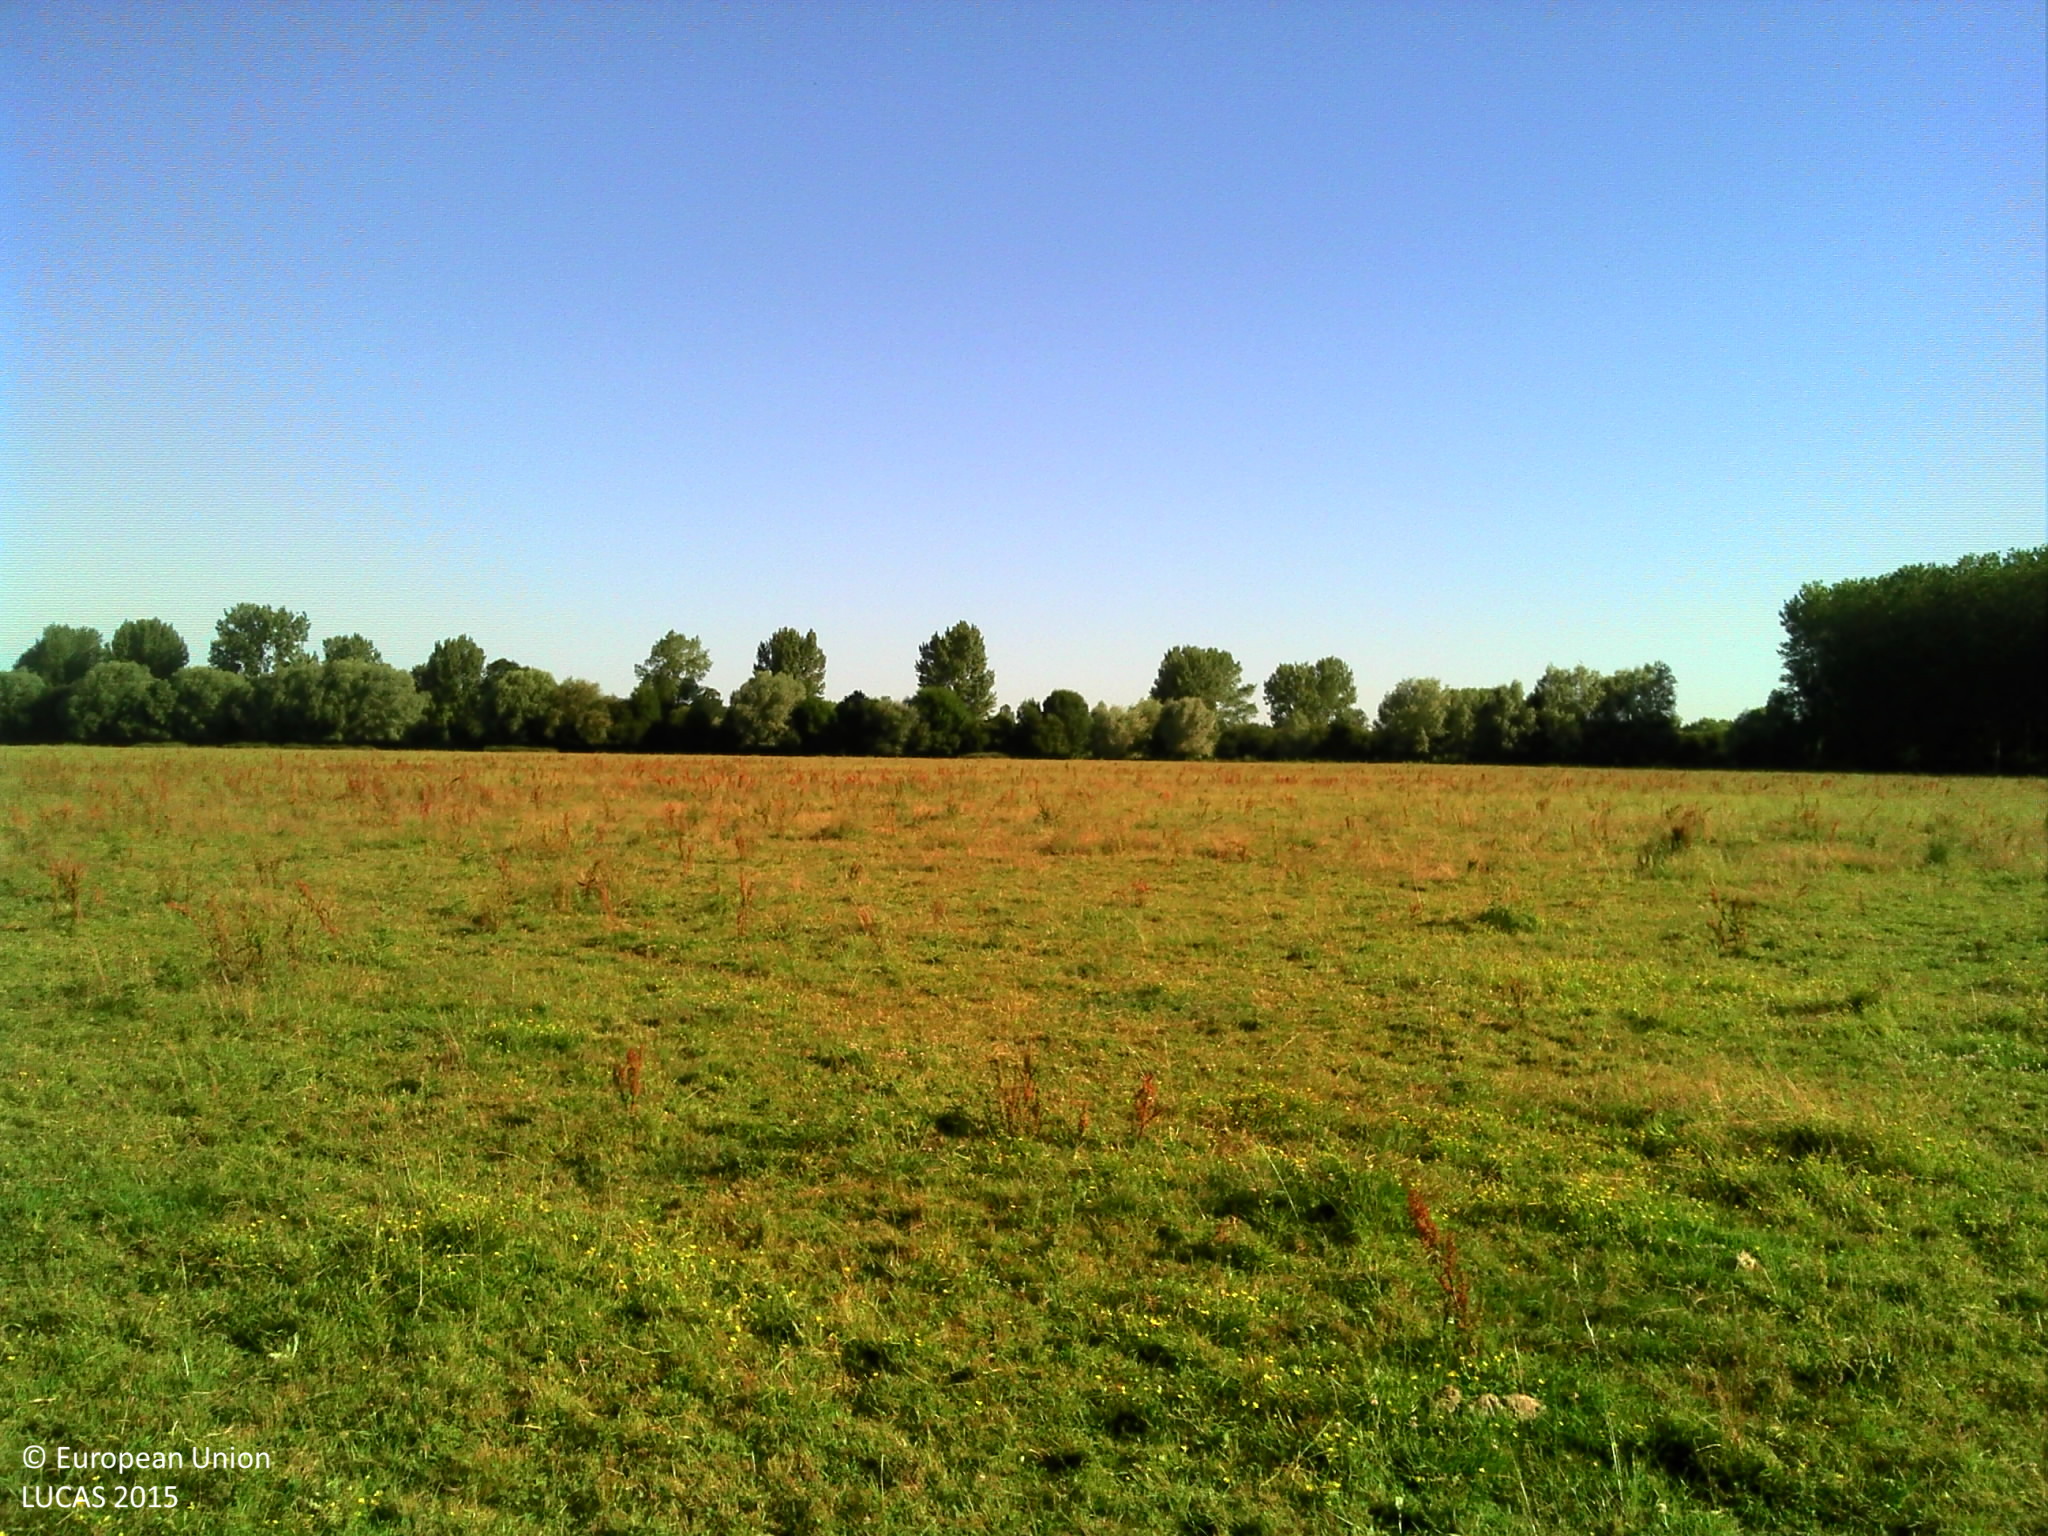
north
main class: Grassland
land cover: Grassland without tree/shrub cover
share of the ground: > 75 %
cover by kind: herbaceous plants 100 %
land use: Agriculture (excluding fallow land and kitchen gardens)
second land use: Amenities, museums, leisure
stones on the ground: < 10 %
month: June
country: FR
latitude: 48.5264
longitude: -1.5164
